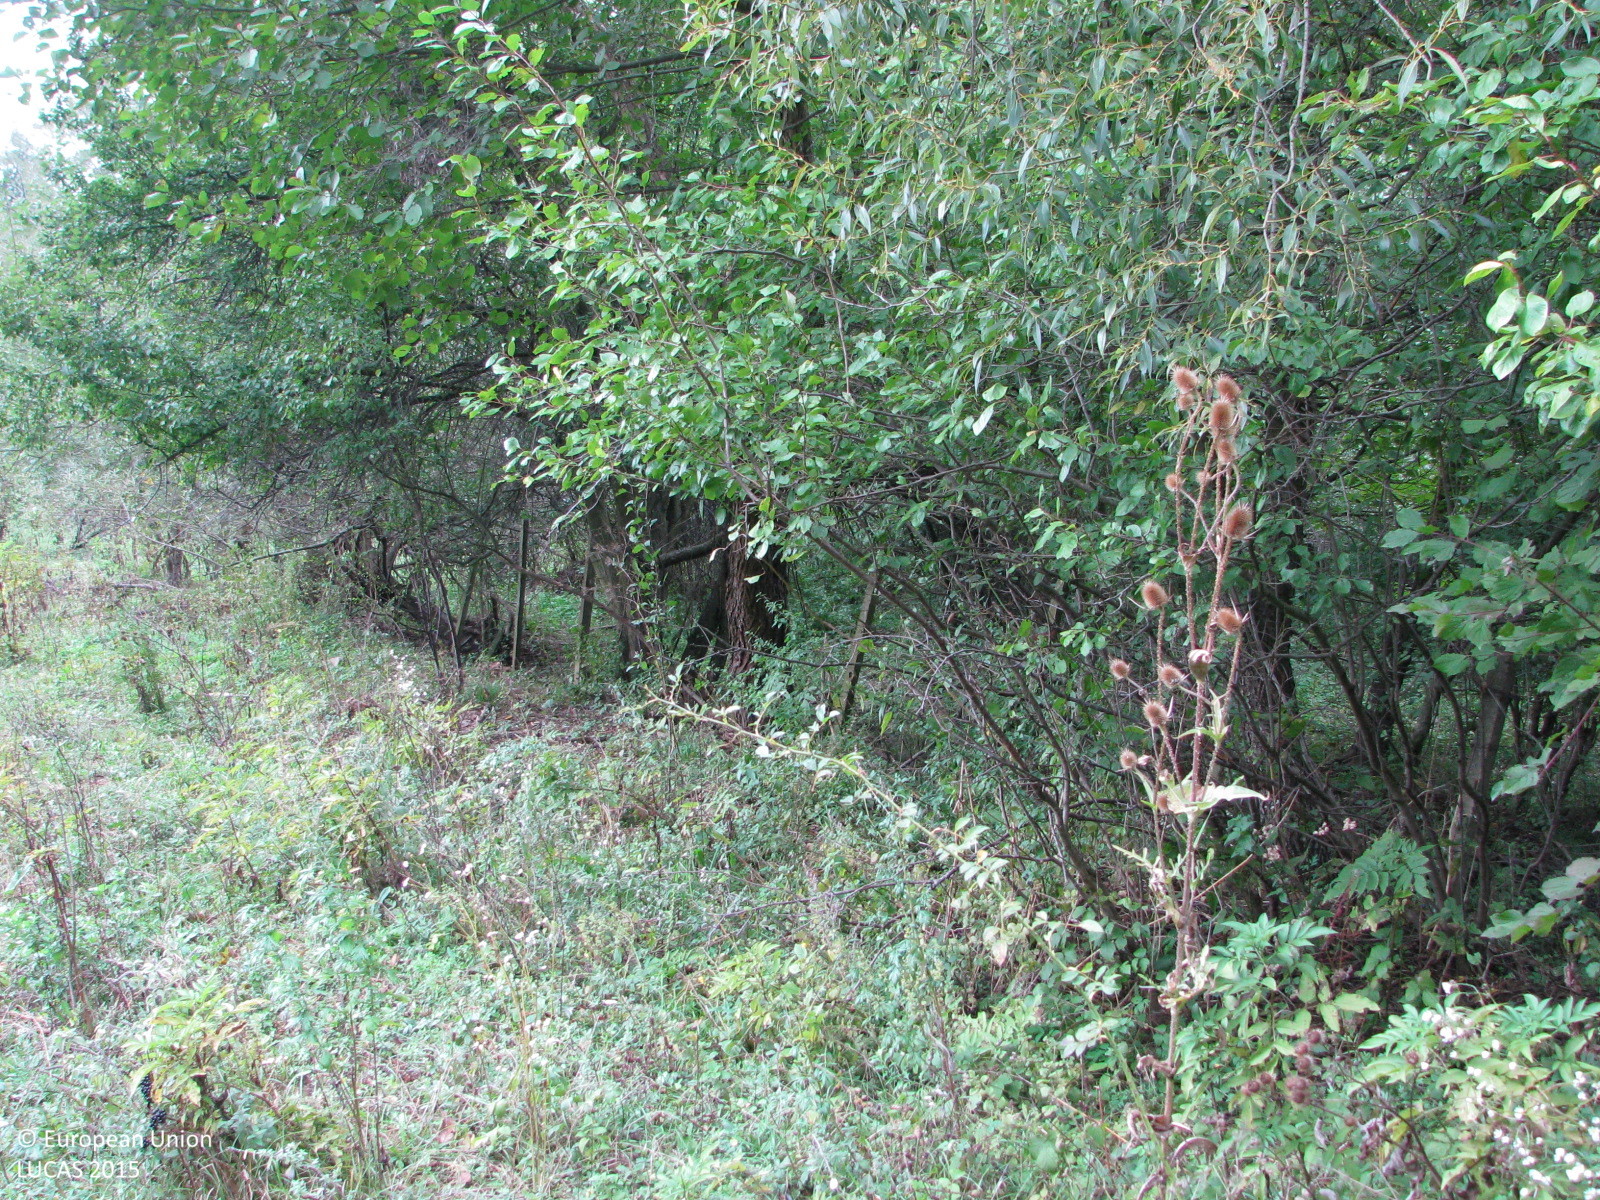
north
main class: Grassland
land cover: Grassland without tree/shrub cover
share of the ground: > 75 %
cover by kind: herbaceous plants 100 %
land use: Agriculture (excluding fallow land and kitchen gardens)
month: September
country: BG
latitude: 42.7680
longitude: 26.4585
